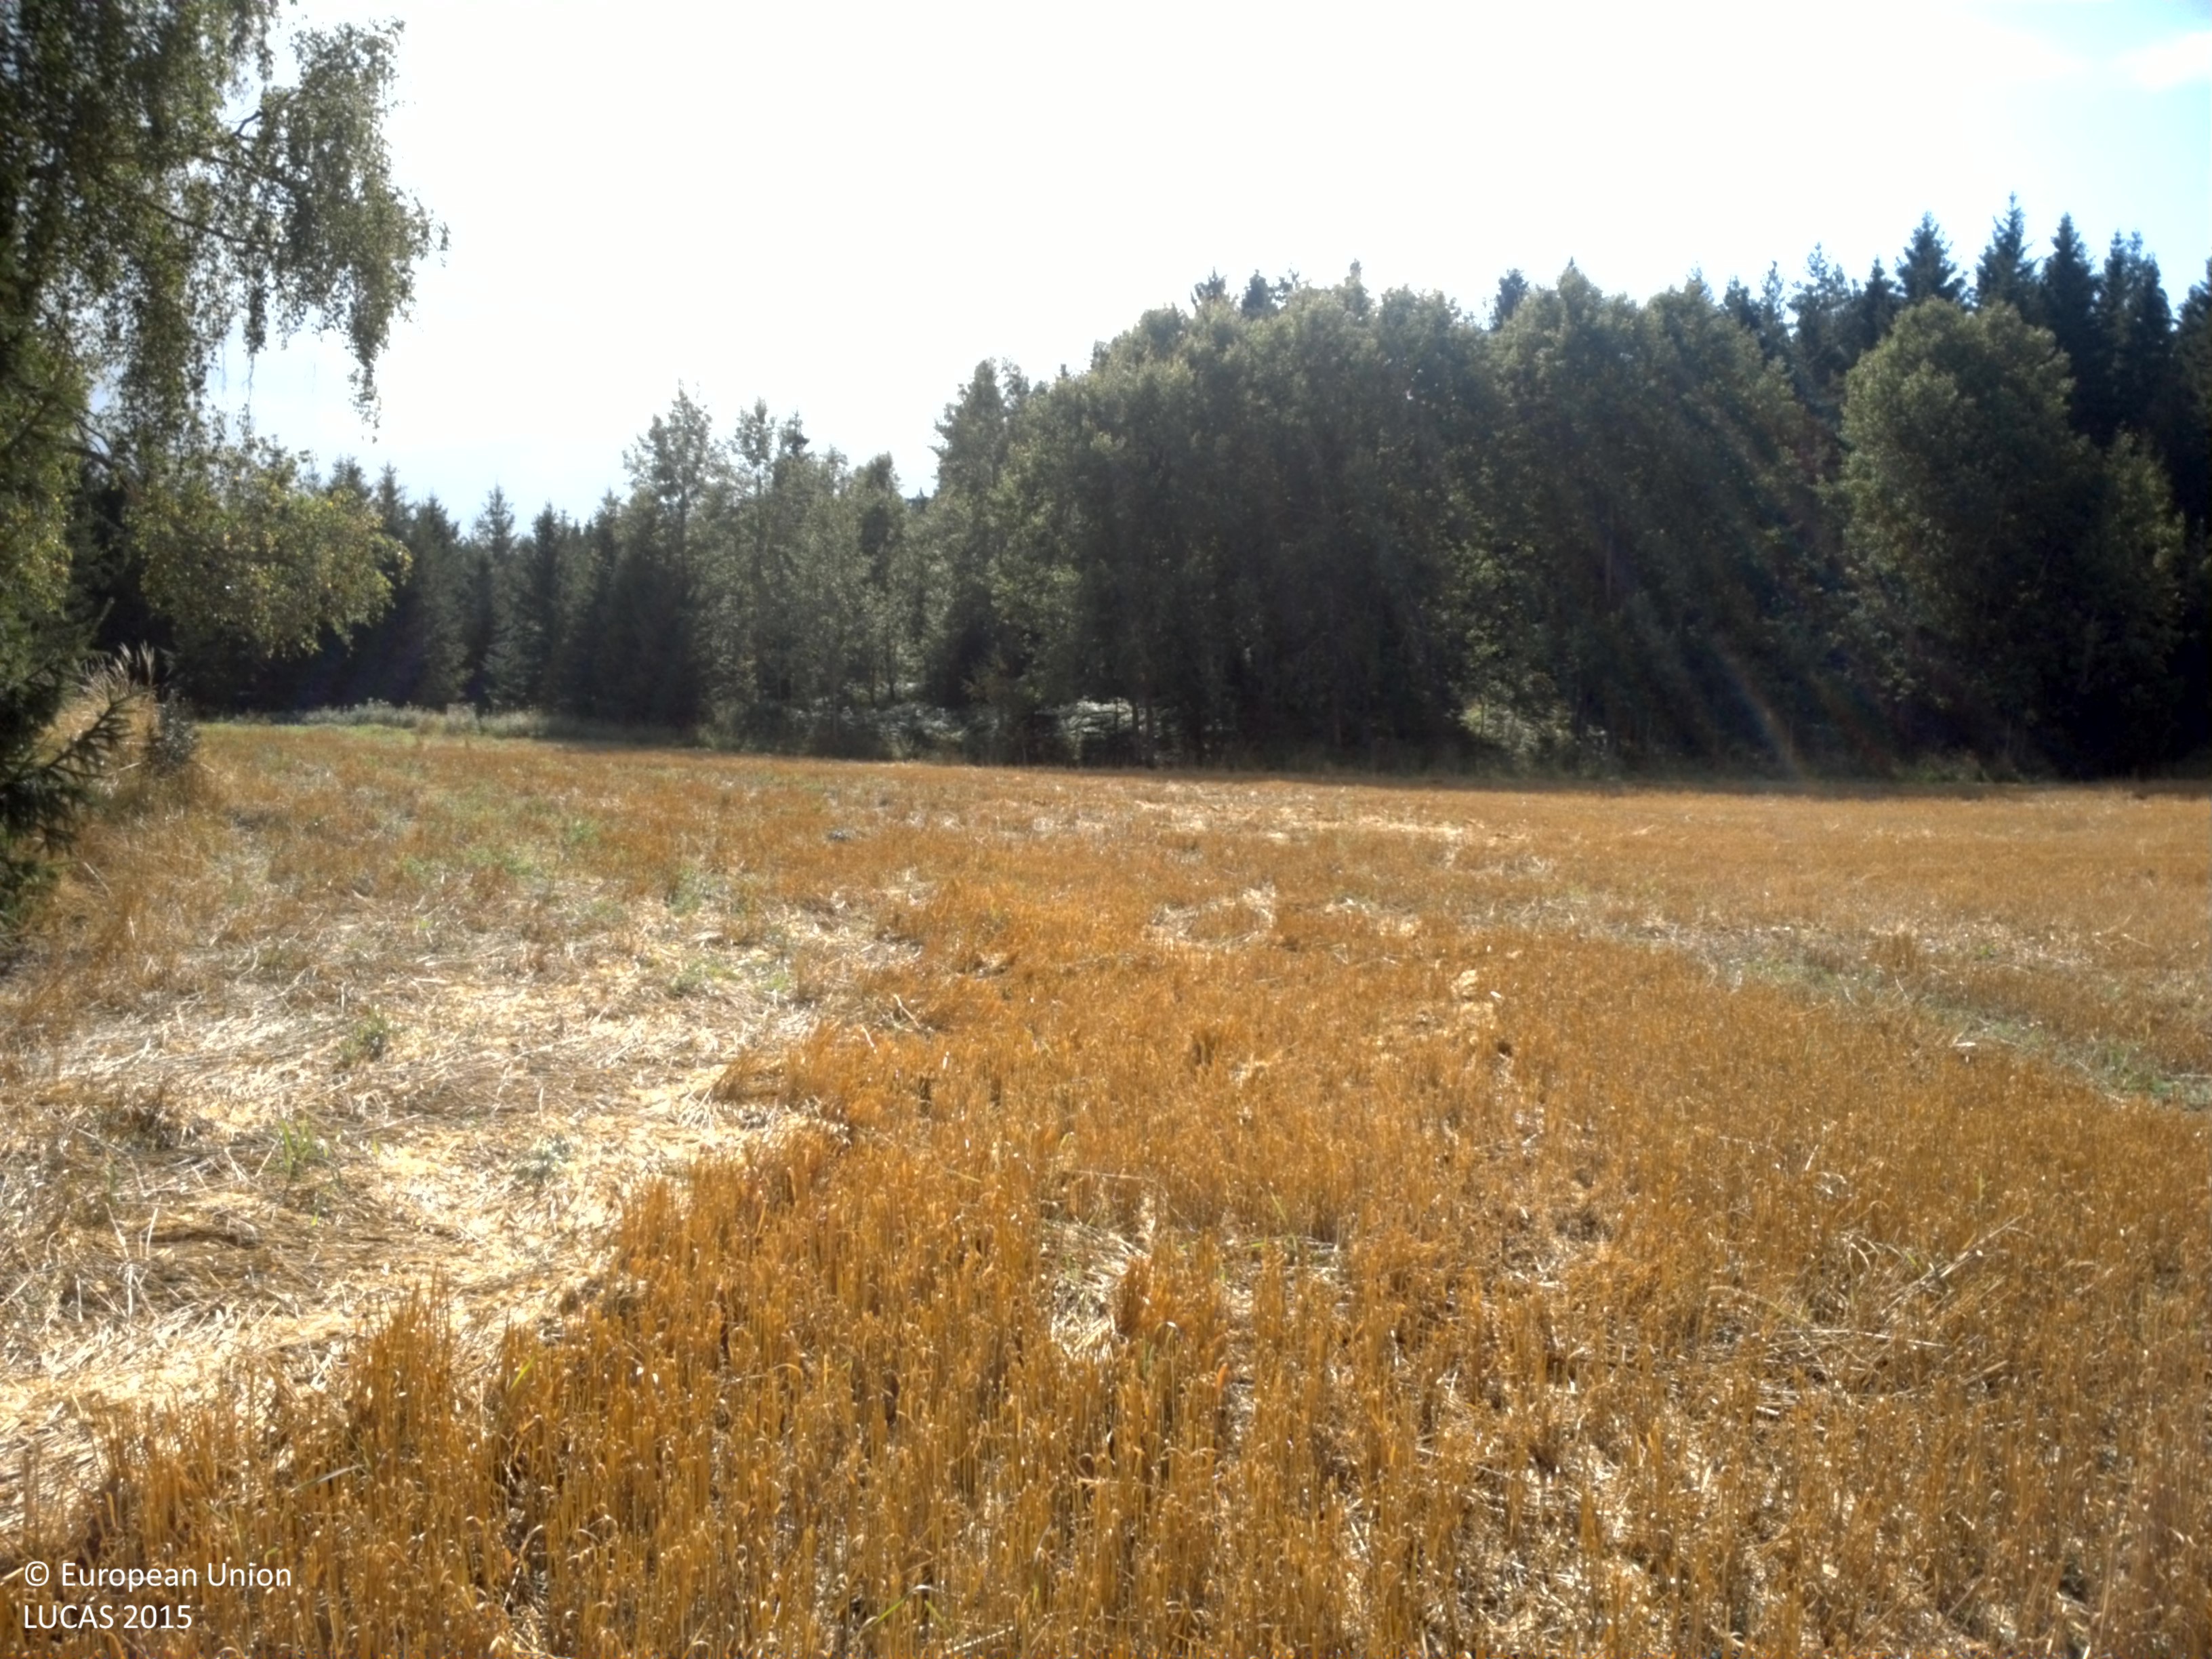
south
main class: Cropland
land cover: Common wheat
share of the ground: 10 - 25 %
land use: Agriculture (excluding fallow land and kitchen gardens)
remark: Harvested field
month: August
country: SE
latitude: 59.9476
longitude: 17.7818
